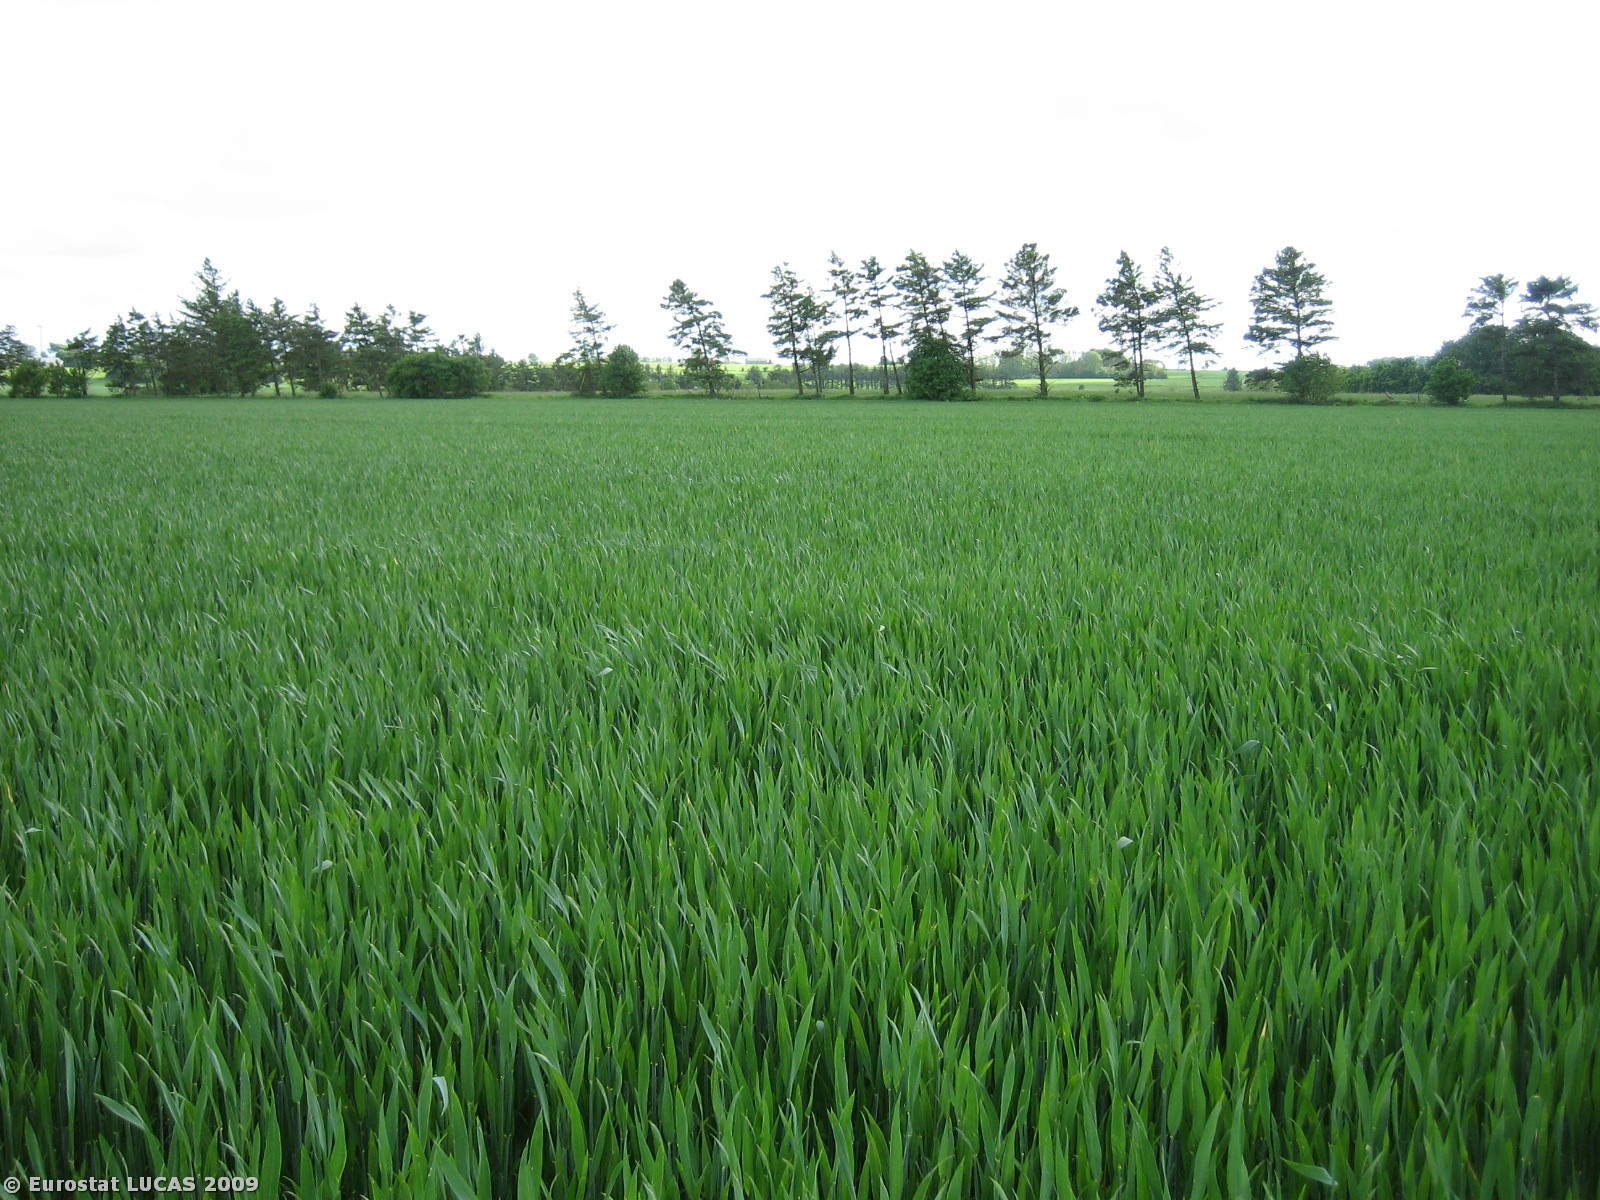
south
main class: Cropland
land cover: Barley
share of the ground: > 75 %
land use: Agriculture (excluding fallow land and kitchen gardens)
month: May
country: DK
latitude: 56.0206
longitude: 8.8301
